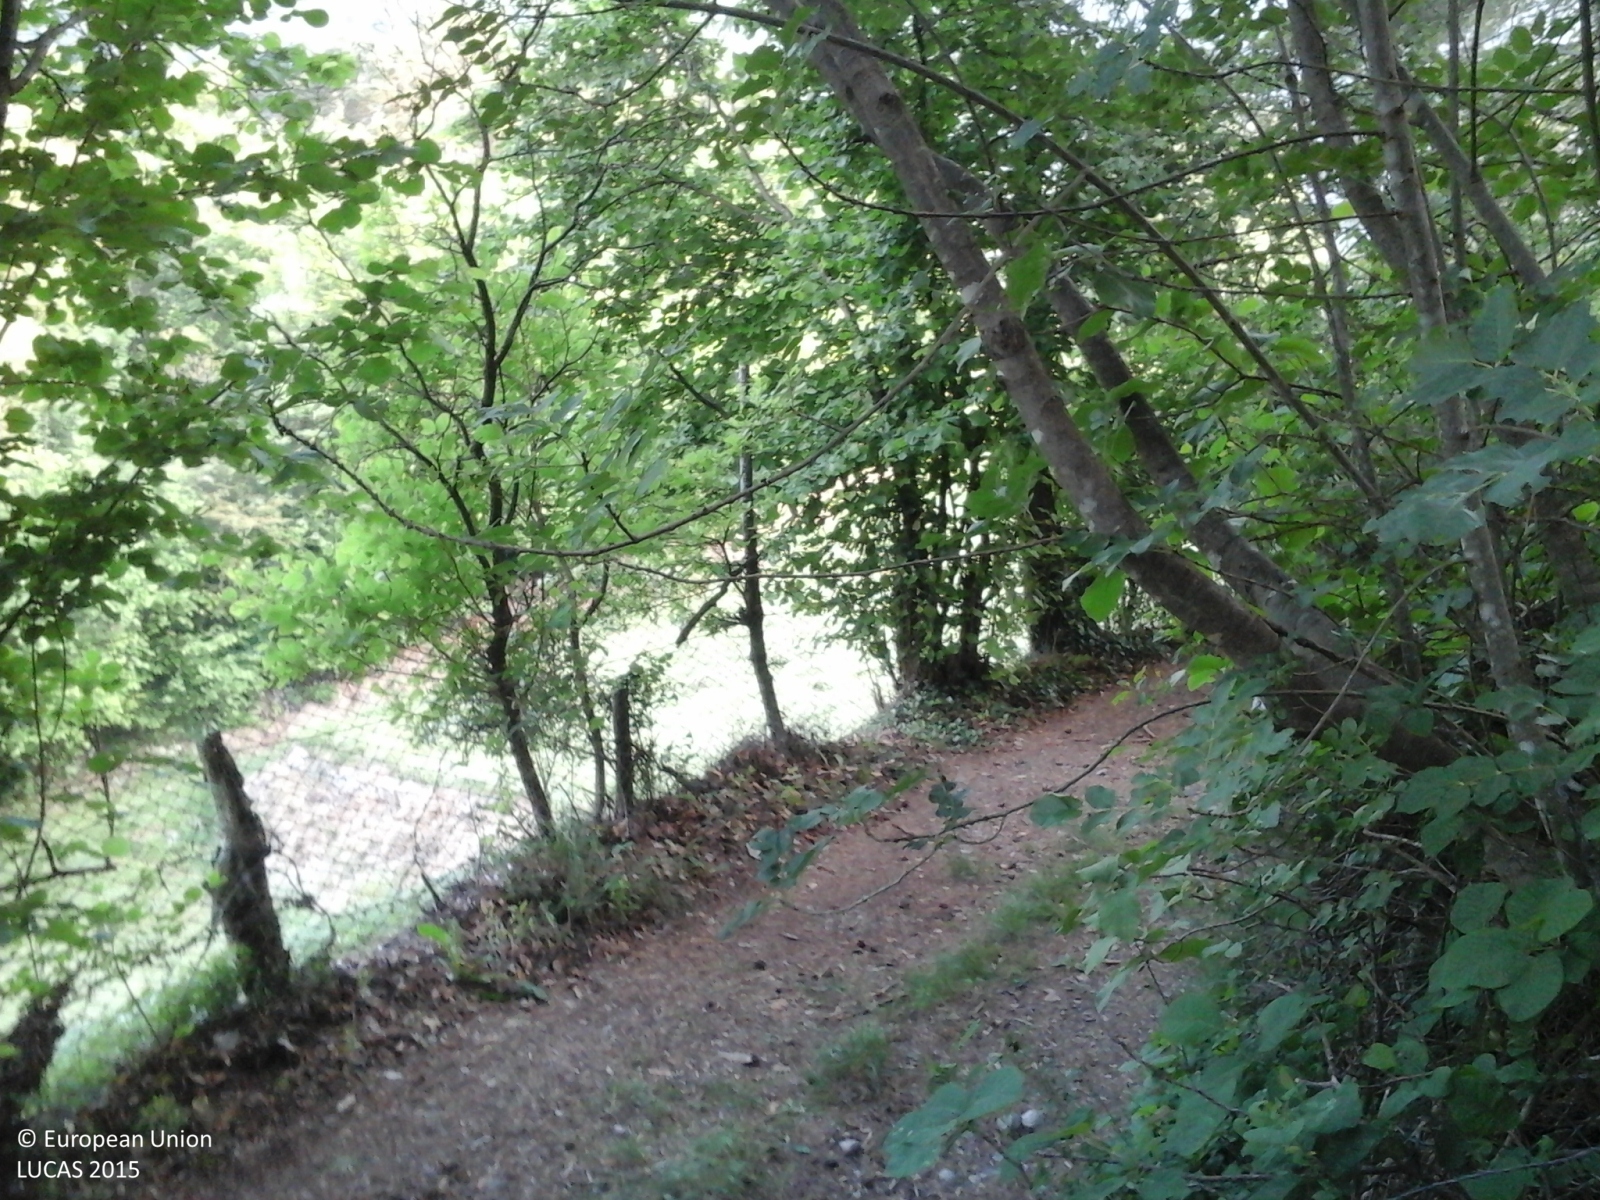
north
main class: Woodland
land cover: Pine dominated coniferous woodland
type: alpine coniferous forest
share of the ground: > 75 %
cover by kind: coniferous forest trees 95 %, broadleaved forest trees 5 %
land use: Forestry
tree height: > 5 m
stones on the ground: 10 - 25 %
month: June
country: IT
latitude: 46.0588
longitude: 10.9422
